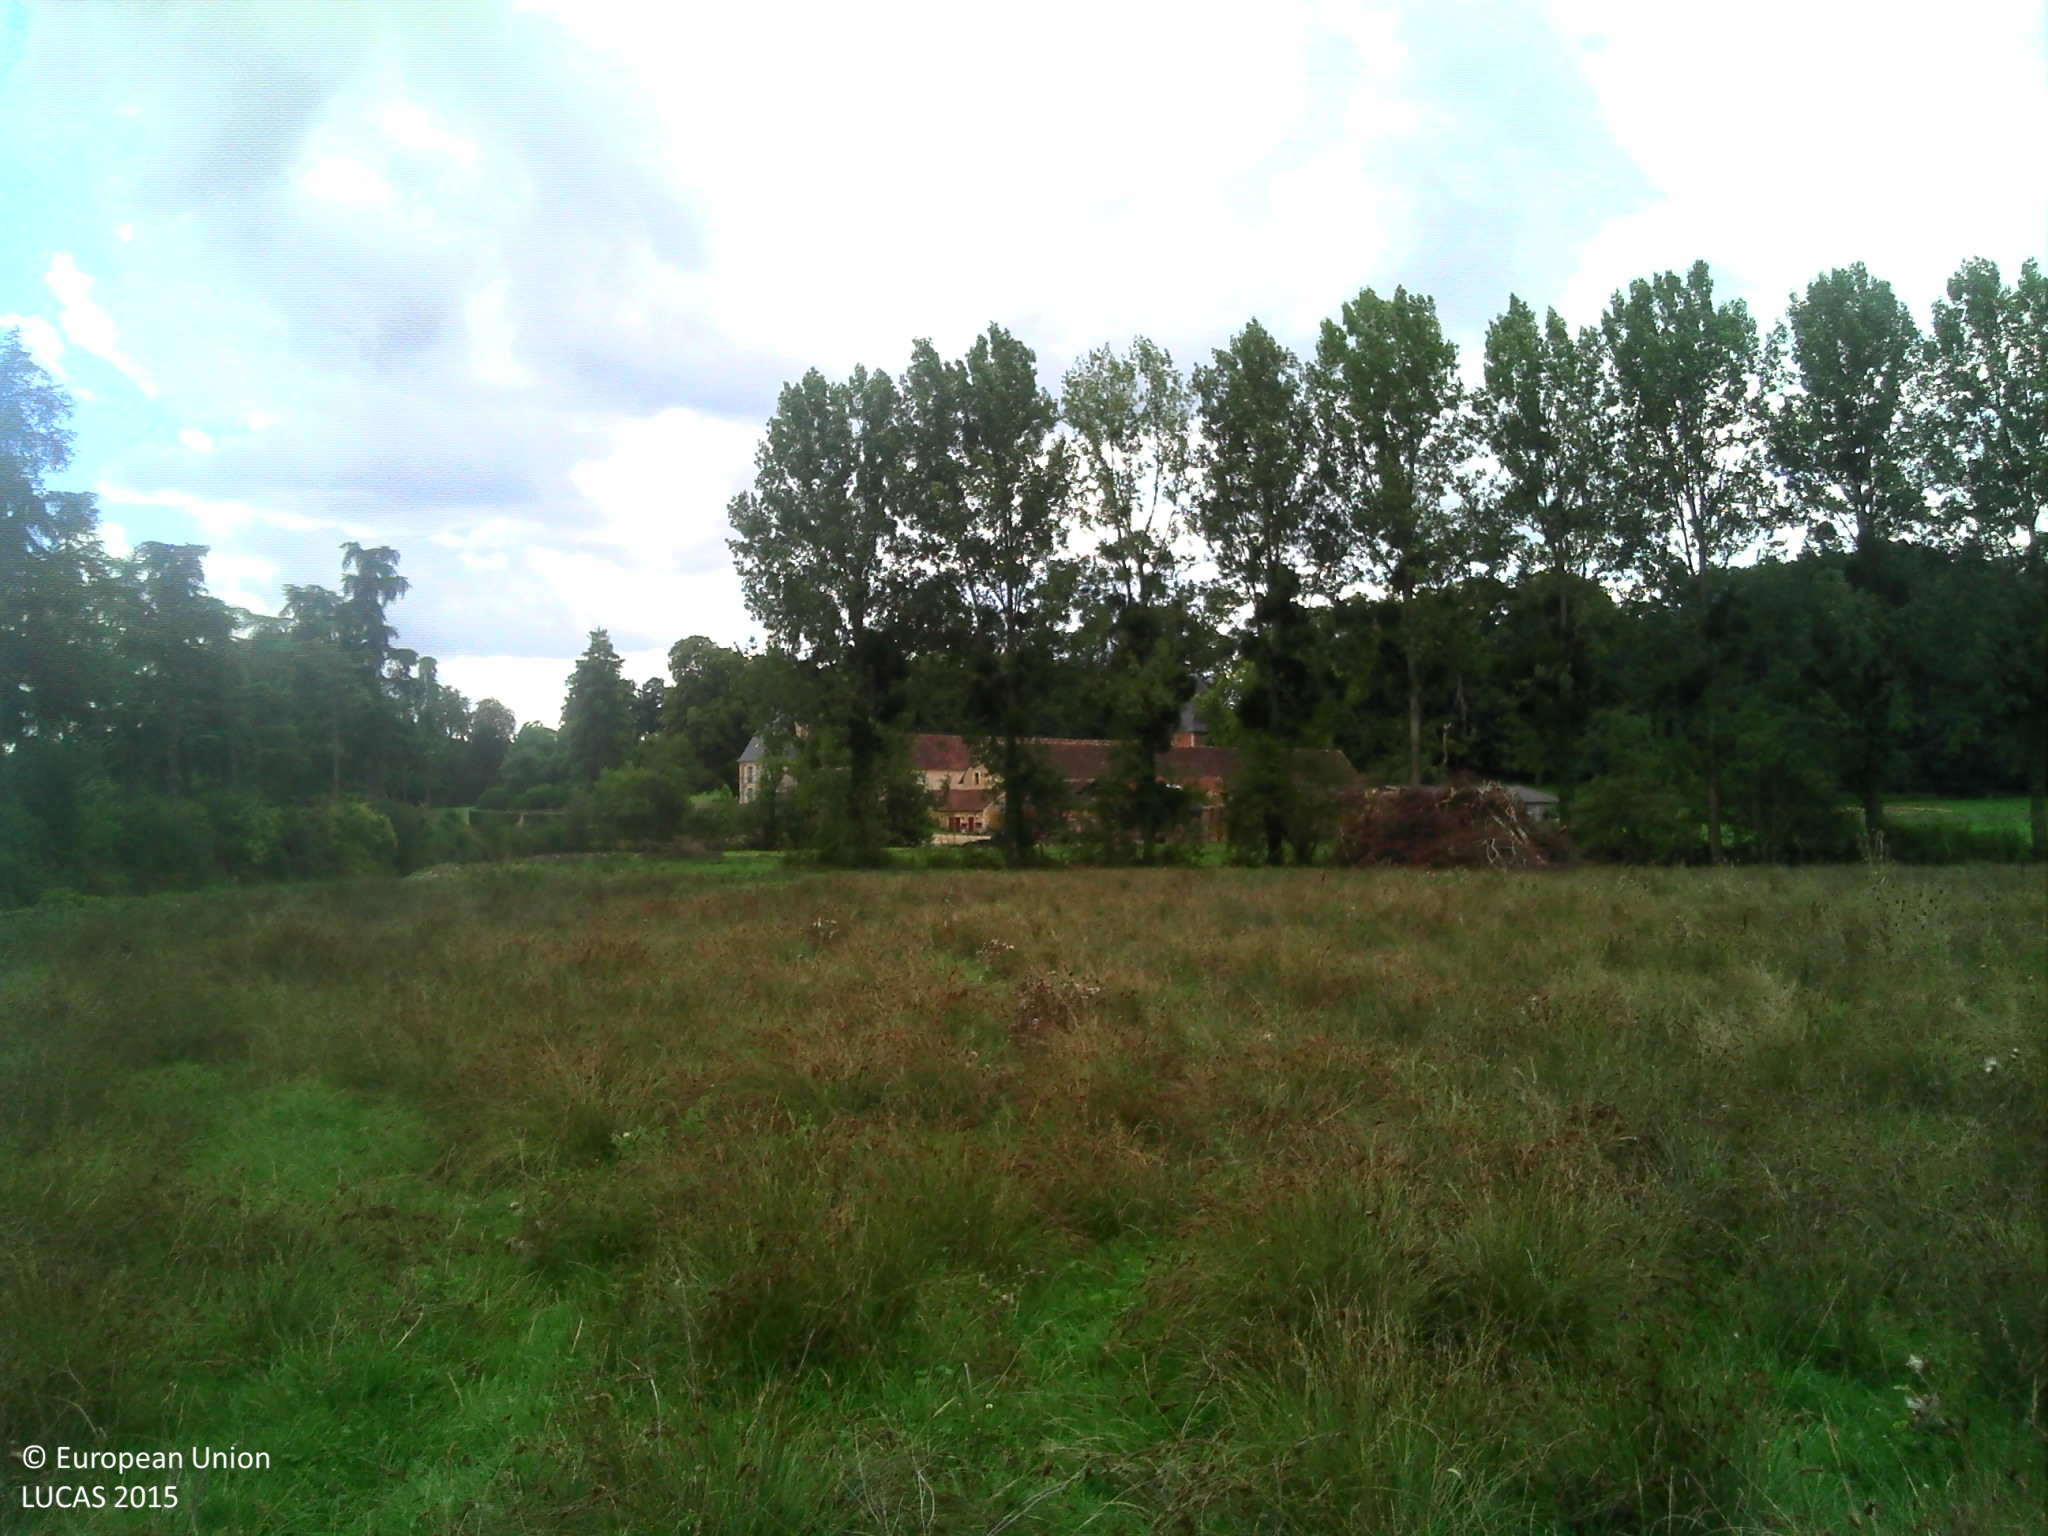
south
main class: Grassland
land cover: Grassland without tree/shrub cover
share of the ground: > 75 %
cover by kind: herbaceous plants 95 %, shrubs 5 %
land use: Agriculture (excluding fallow land and kitchen gardens)
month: September
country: FR
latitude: 48.3038
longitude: 0.5252
